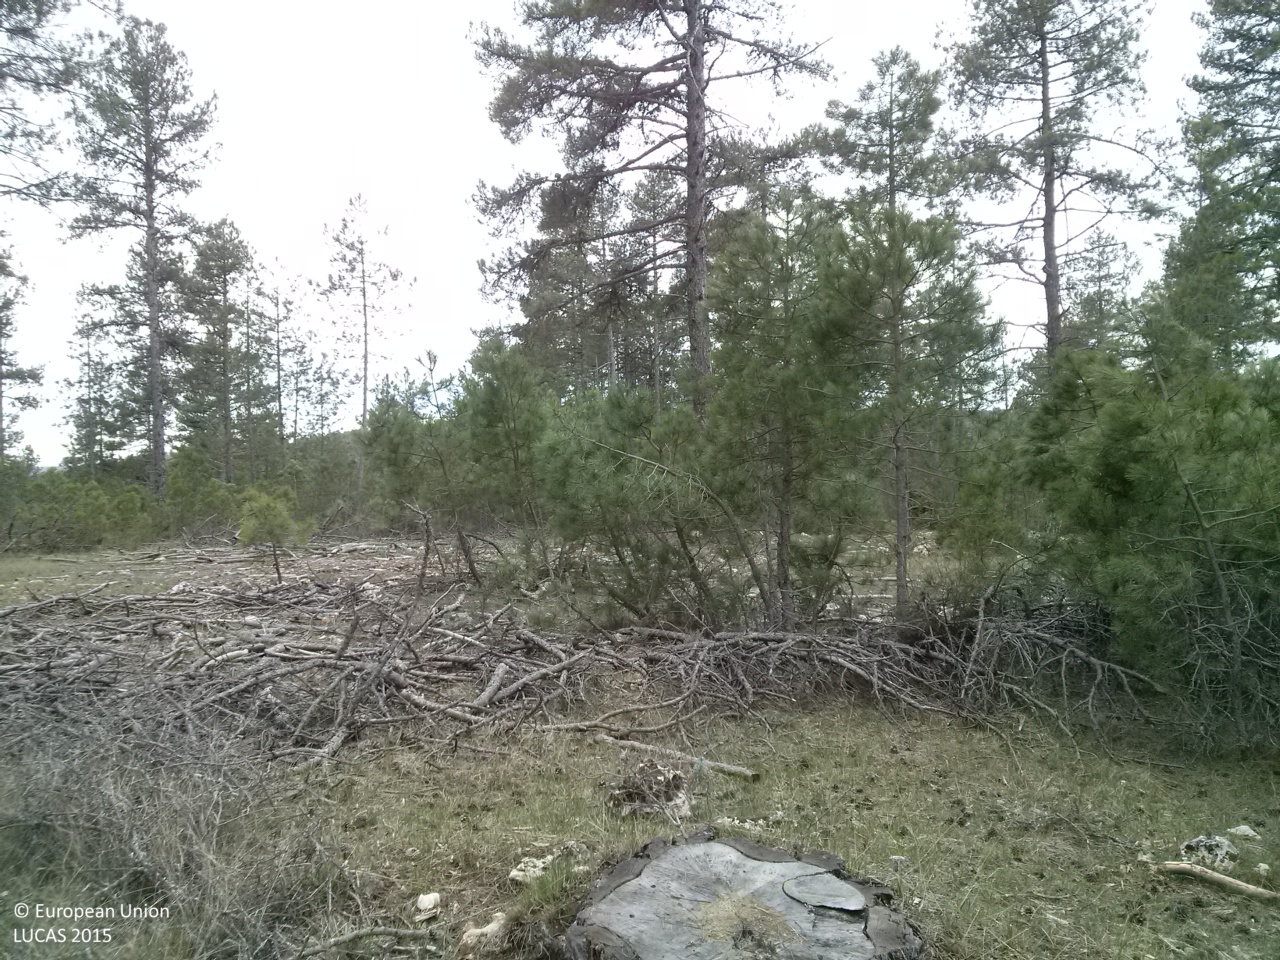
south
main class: Woodland
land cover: Pine dominated coniferous woodland
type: coniferous forest of the mediterranean region
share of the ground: 25 - 50 %
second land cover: Grassland without tree/shrub cover
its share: > 75 %
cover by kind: herbaceous plants 60 %, coniferous forest trees 40 %
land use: Forestry
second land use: Agriculture (excluding fallow land and kitchen gardens)
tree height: > 5 m
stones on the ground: 10 - 25 %
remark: Burnt area
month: April
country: ES
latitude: 40.2468
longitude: -1.9482
